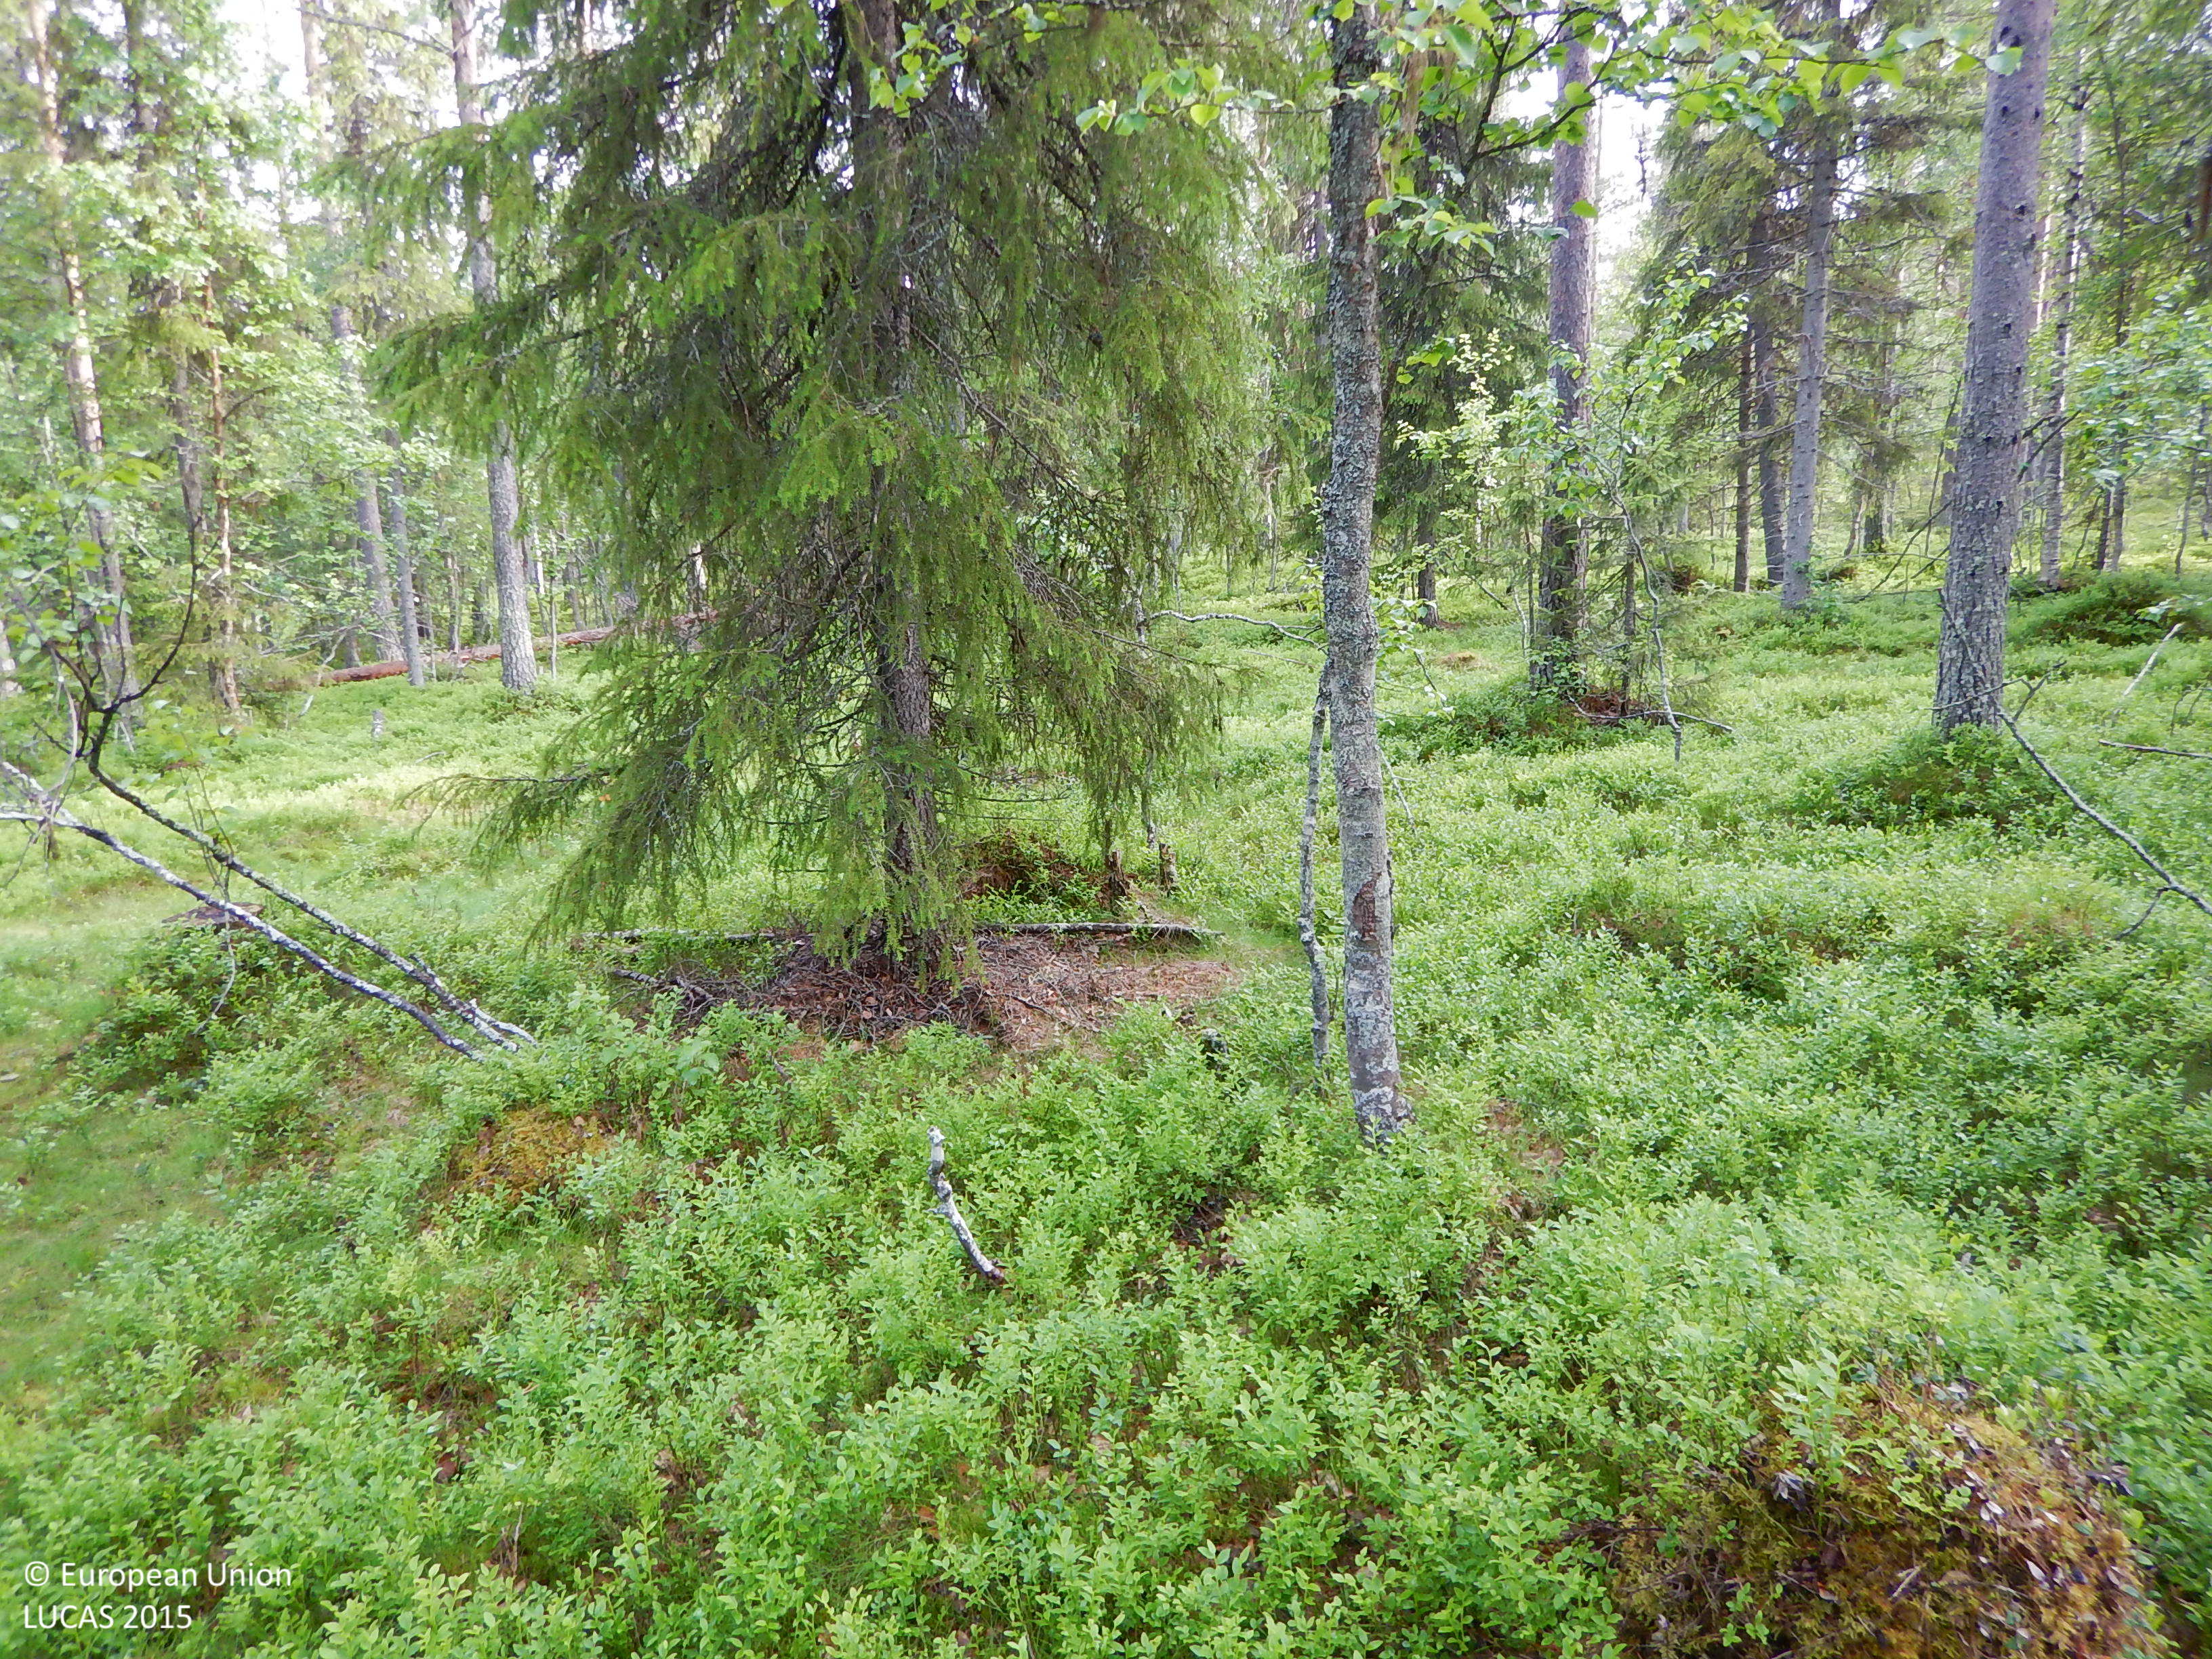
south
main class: Woodland
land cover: Other mixed woodland
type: boreal forest
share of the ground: 50 - 75 %
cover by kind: coniferous forest trees 45 %, shrubs 20 %, broadleaved forest trees 15 %, herbaceous plants 15 %, lichens and mosses 5 %
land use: Forestry
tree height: > 5 m
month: July
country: SE
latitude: 65.2935
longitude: 19.2479
